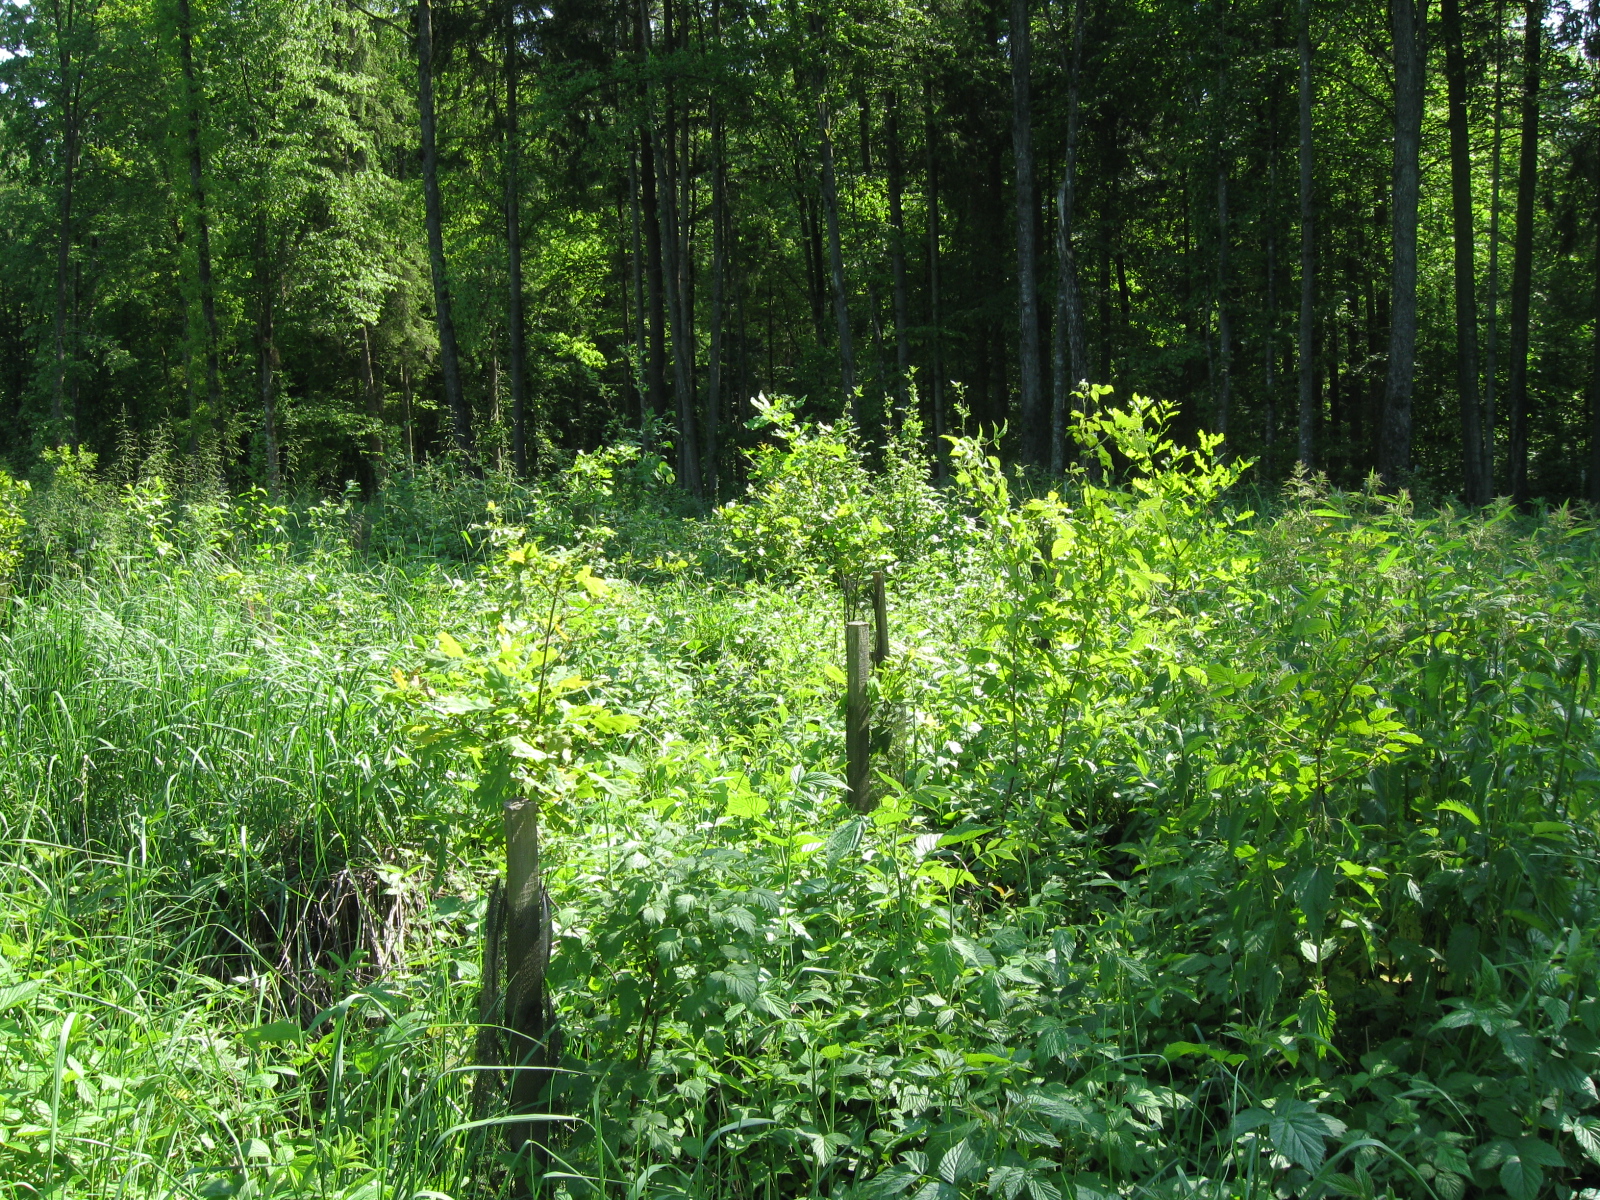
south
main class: Woodland
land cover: Broadleaved woodland
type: non-riverine alder, birch or aspen forest
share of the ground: 10 - 25 %
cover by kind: herbaceous plants 70 %, broadleaved forest trees 15 %, shrubs 10 %, coniferous forest trees 5 %
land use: Forestry
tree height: < 5 m
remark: Nursery
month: June
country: LT
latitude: 54.2682
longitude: 23.8000
